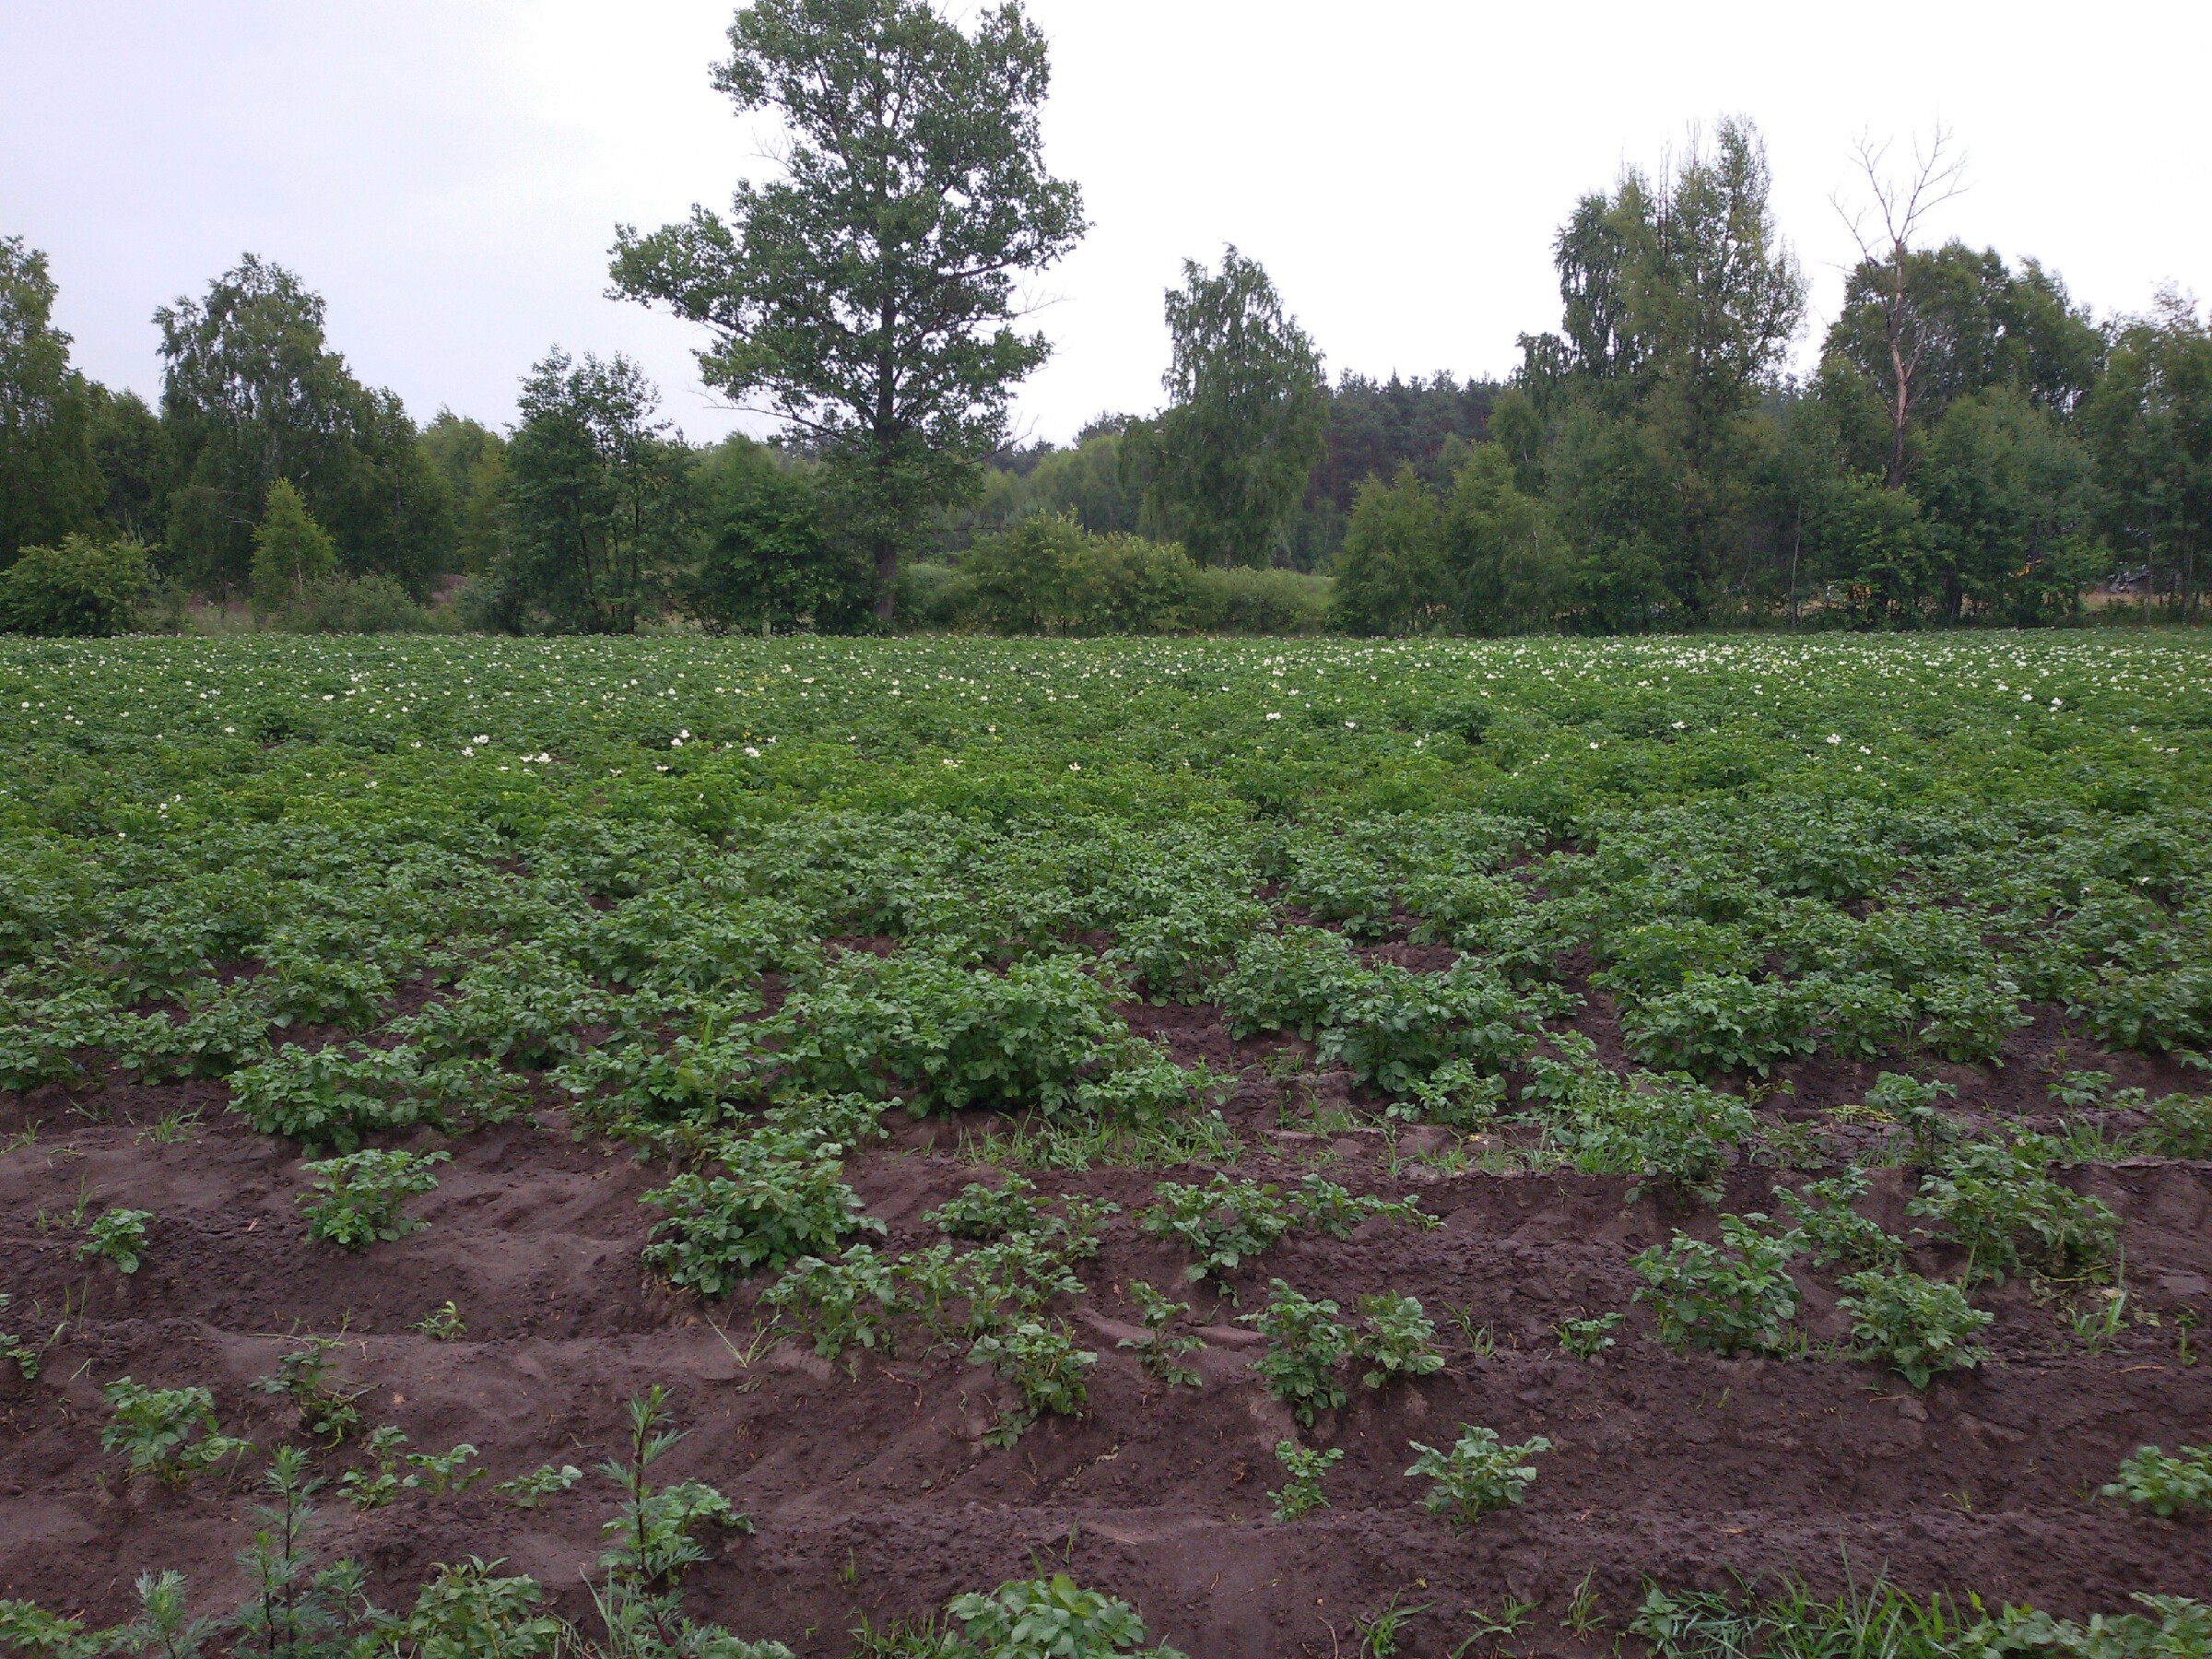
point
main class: Cropland
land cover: Potatoes
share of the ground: > 75 %
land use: Agriculture (excluding fallow land and kitchen gardens)
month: June
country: PL
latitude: 51.9940
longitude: 22.9338
